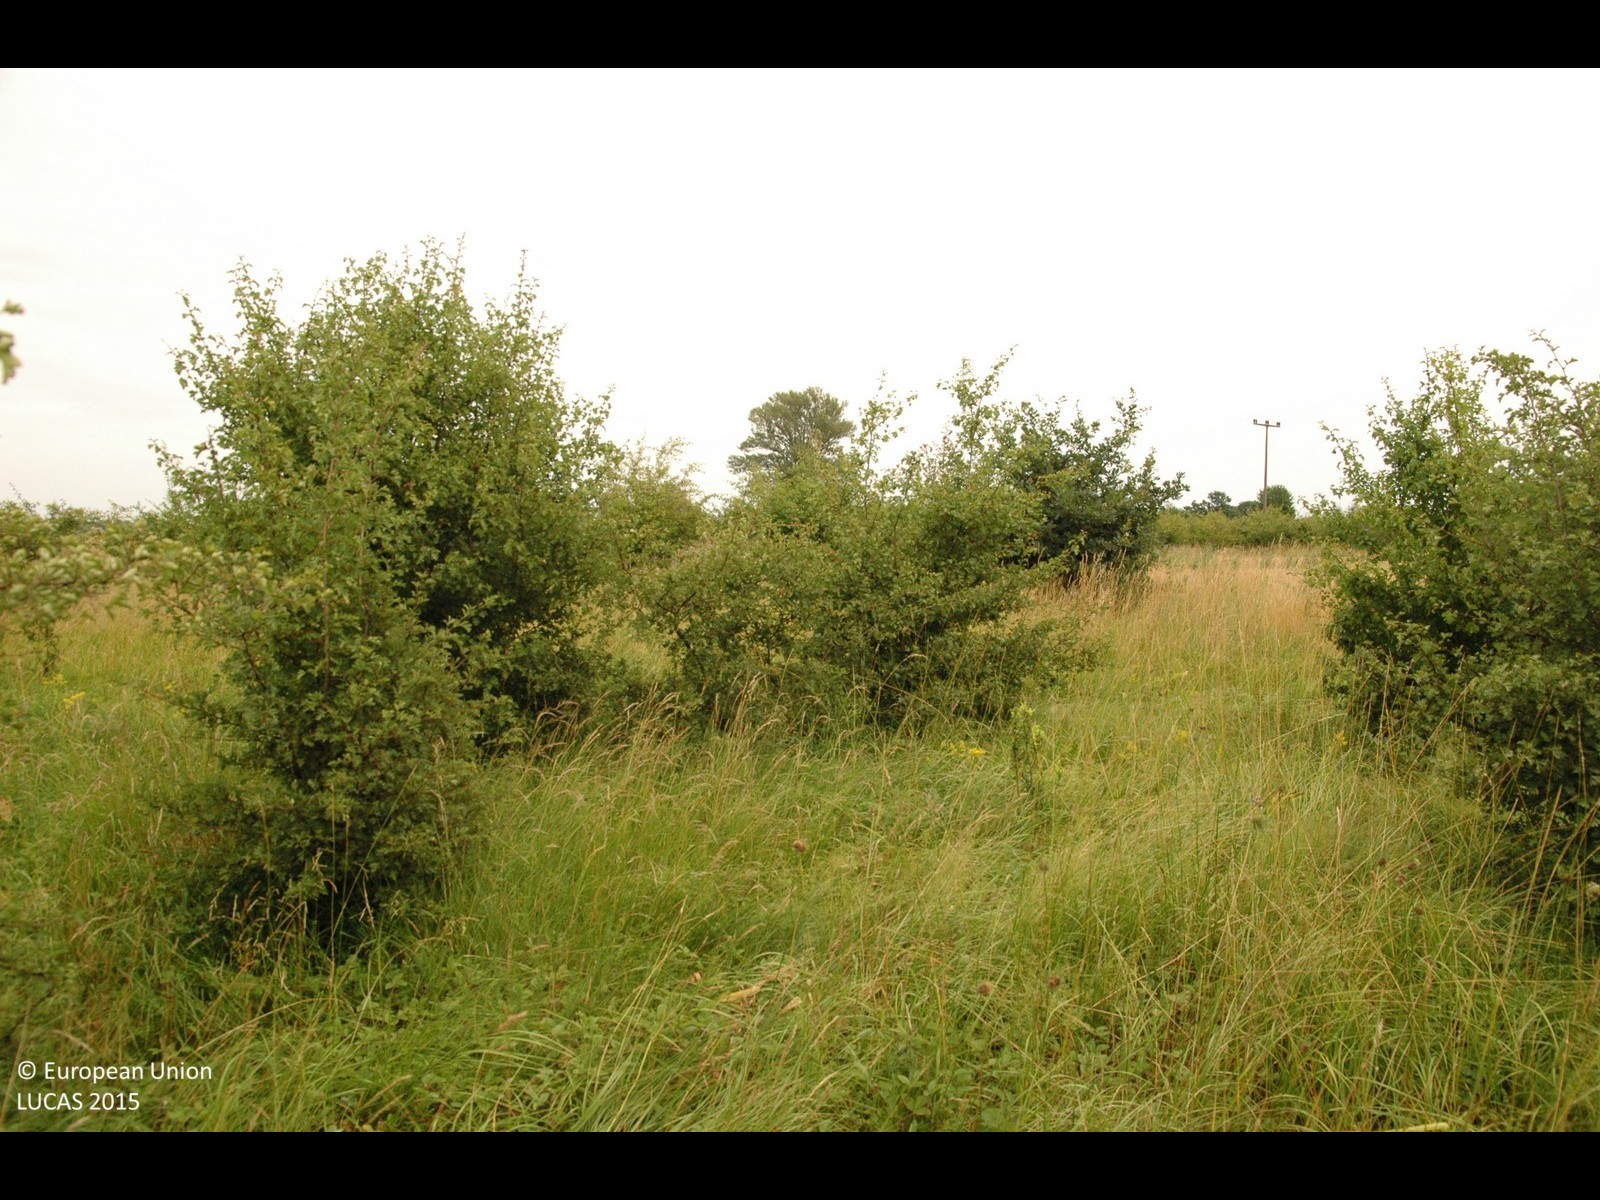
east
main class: Grassland
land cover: Grassland with sparse tree/shrub cover
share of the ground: > 75 %
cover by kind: herbaceous plants 85 %, shrubs 10 %, broadleaved forest trees 5 %
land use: Abandoned areas
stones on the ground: < 10 %
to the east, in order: Grassland with sparse tree/shrub cover; Tracks; Grassland with sparse tree/shrub cover; Barley; Grassland with sparse tree/shrub cover; Tracks; Ditches and canals; Tracks; Grassland without tree/shrub cover; Single bushes/trees
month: June
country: HR
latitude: 46.3788
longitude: 16.3581
